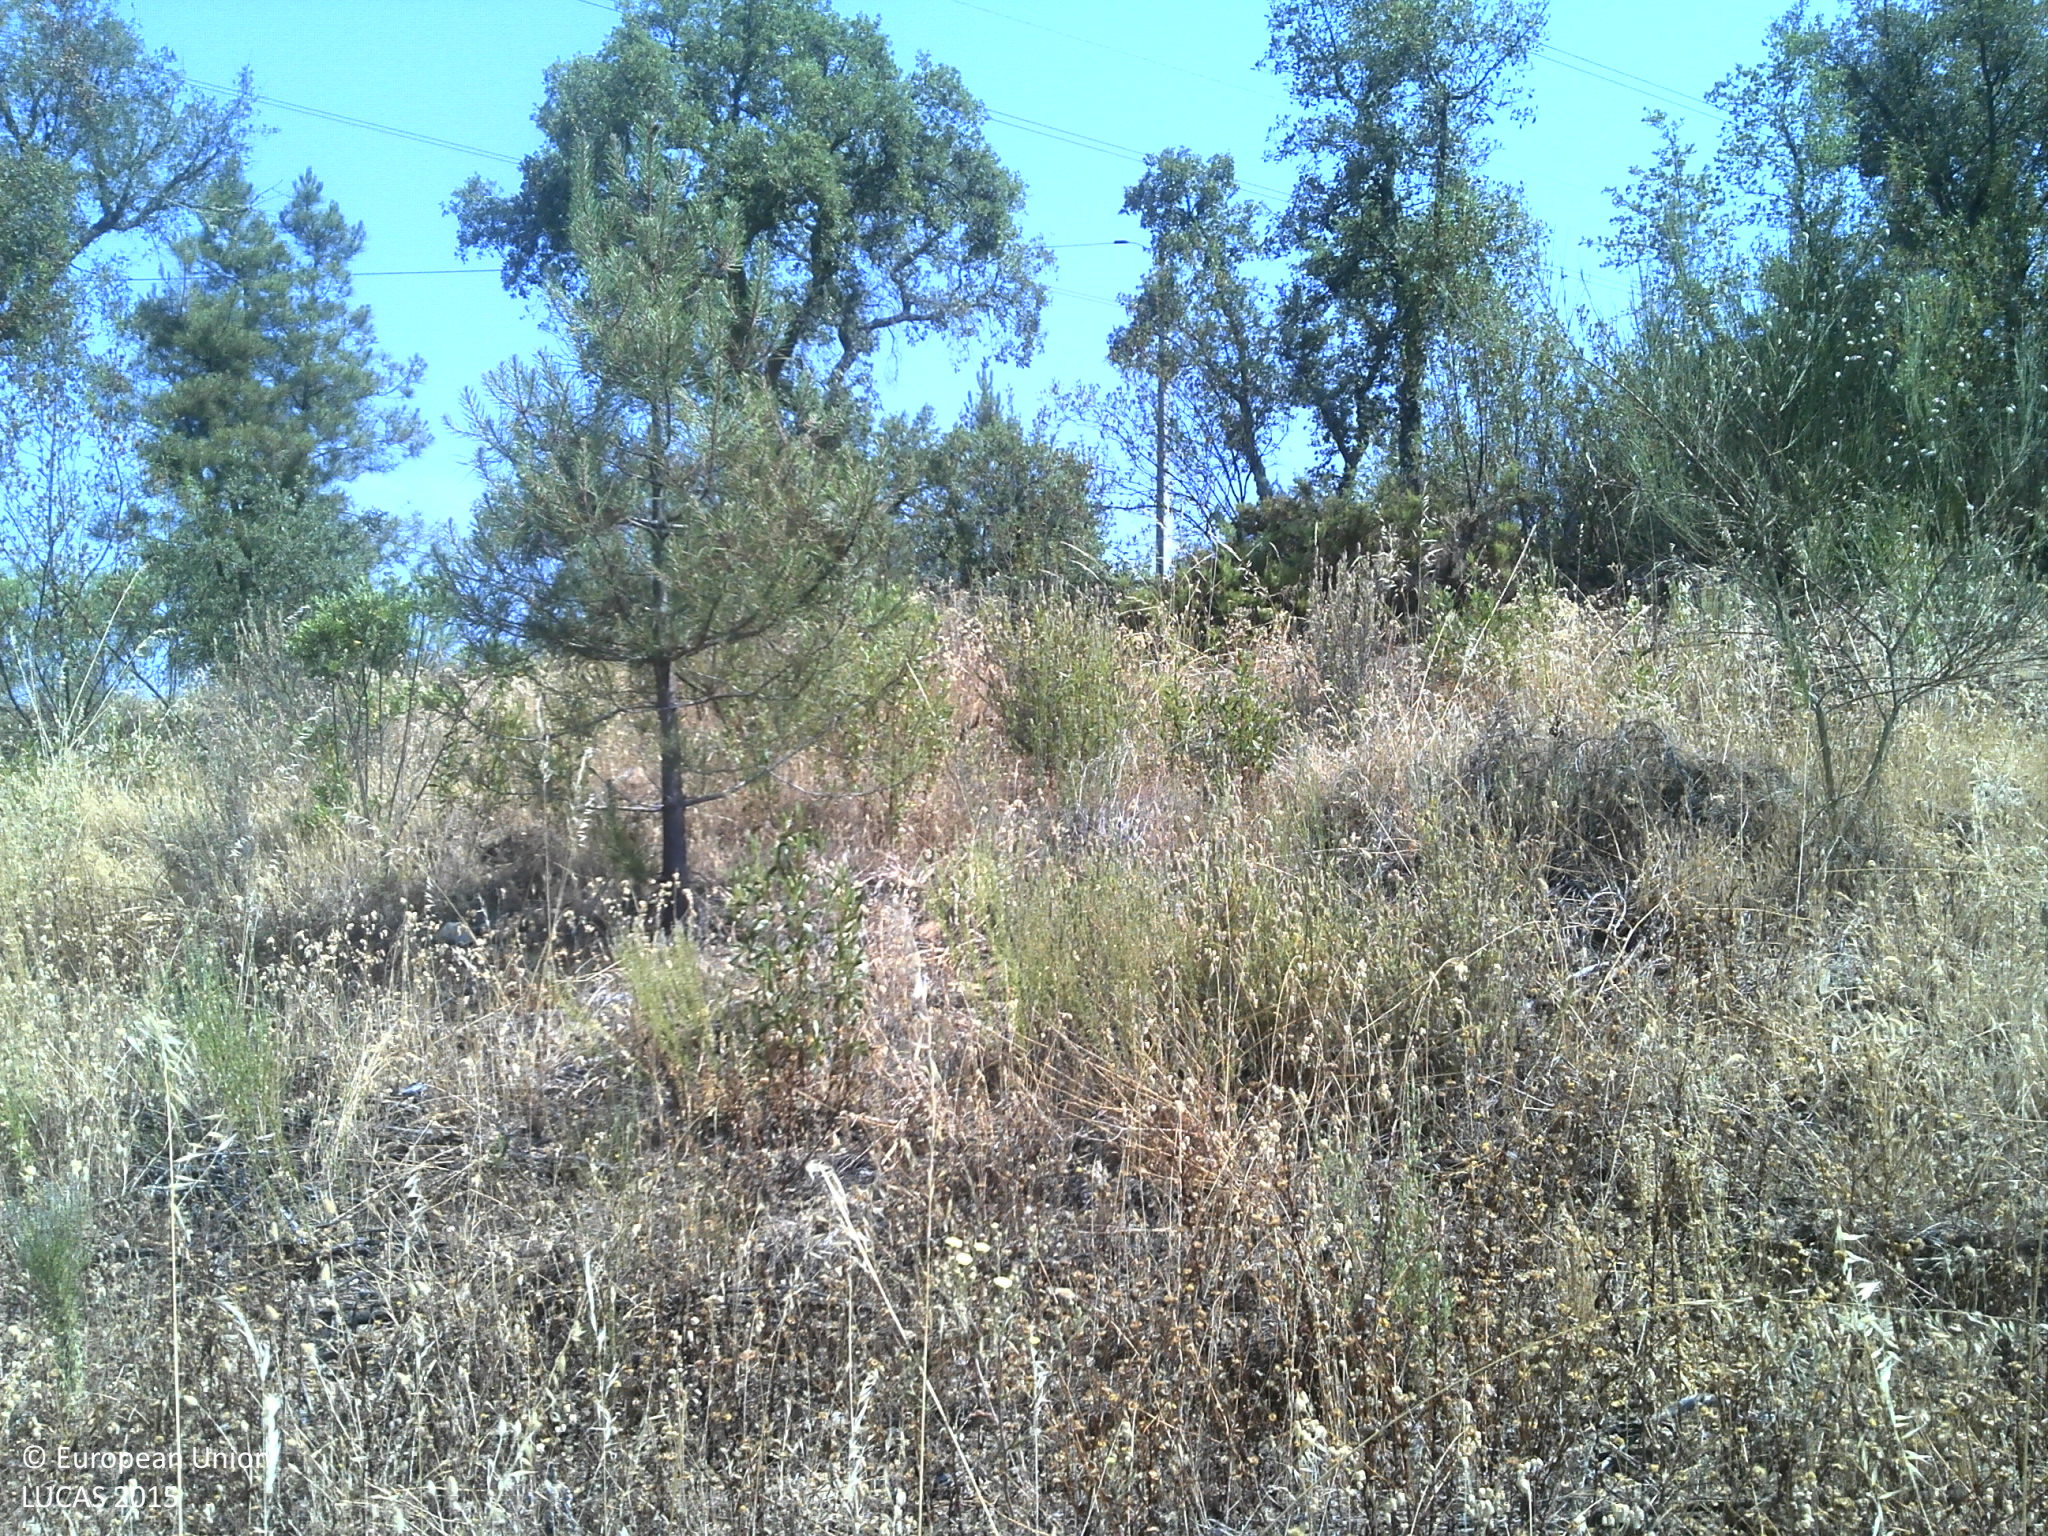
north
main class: Shrubland
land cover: Shrubland with sparse tree cover
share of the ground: > 75 %
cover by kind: shrubs 80 %, lichens and mosses 10 %, broadleaved forest trees 5 %, unconsolidated bare surface 5 %
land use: Semi-natural and natural areas not in use
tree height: < 5 m
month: June
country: PT
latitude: 39.4526
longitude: -7.9178
